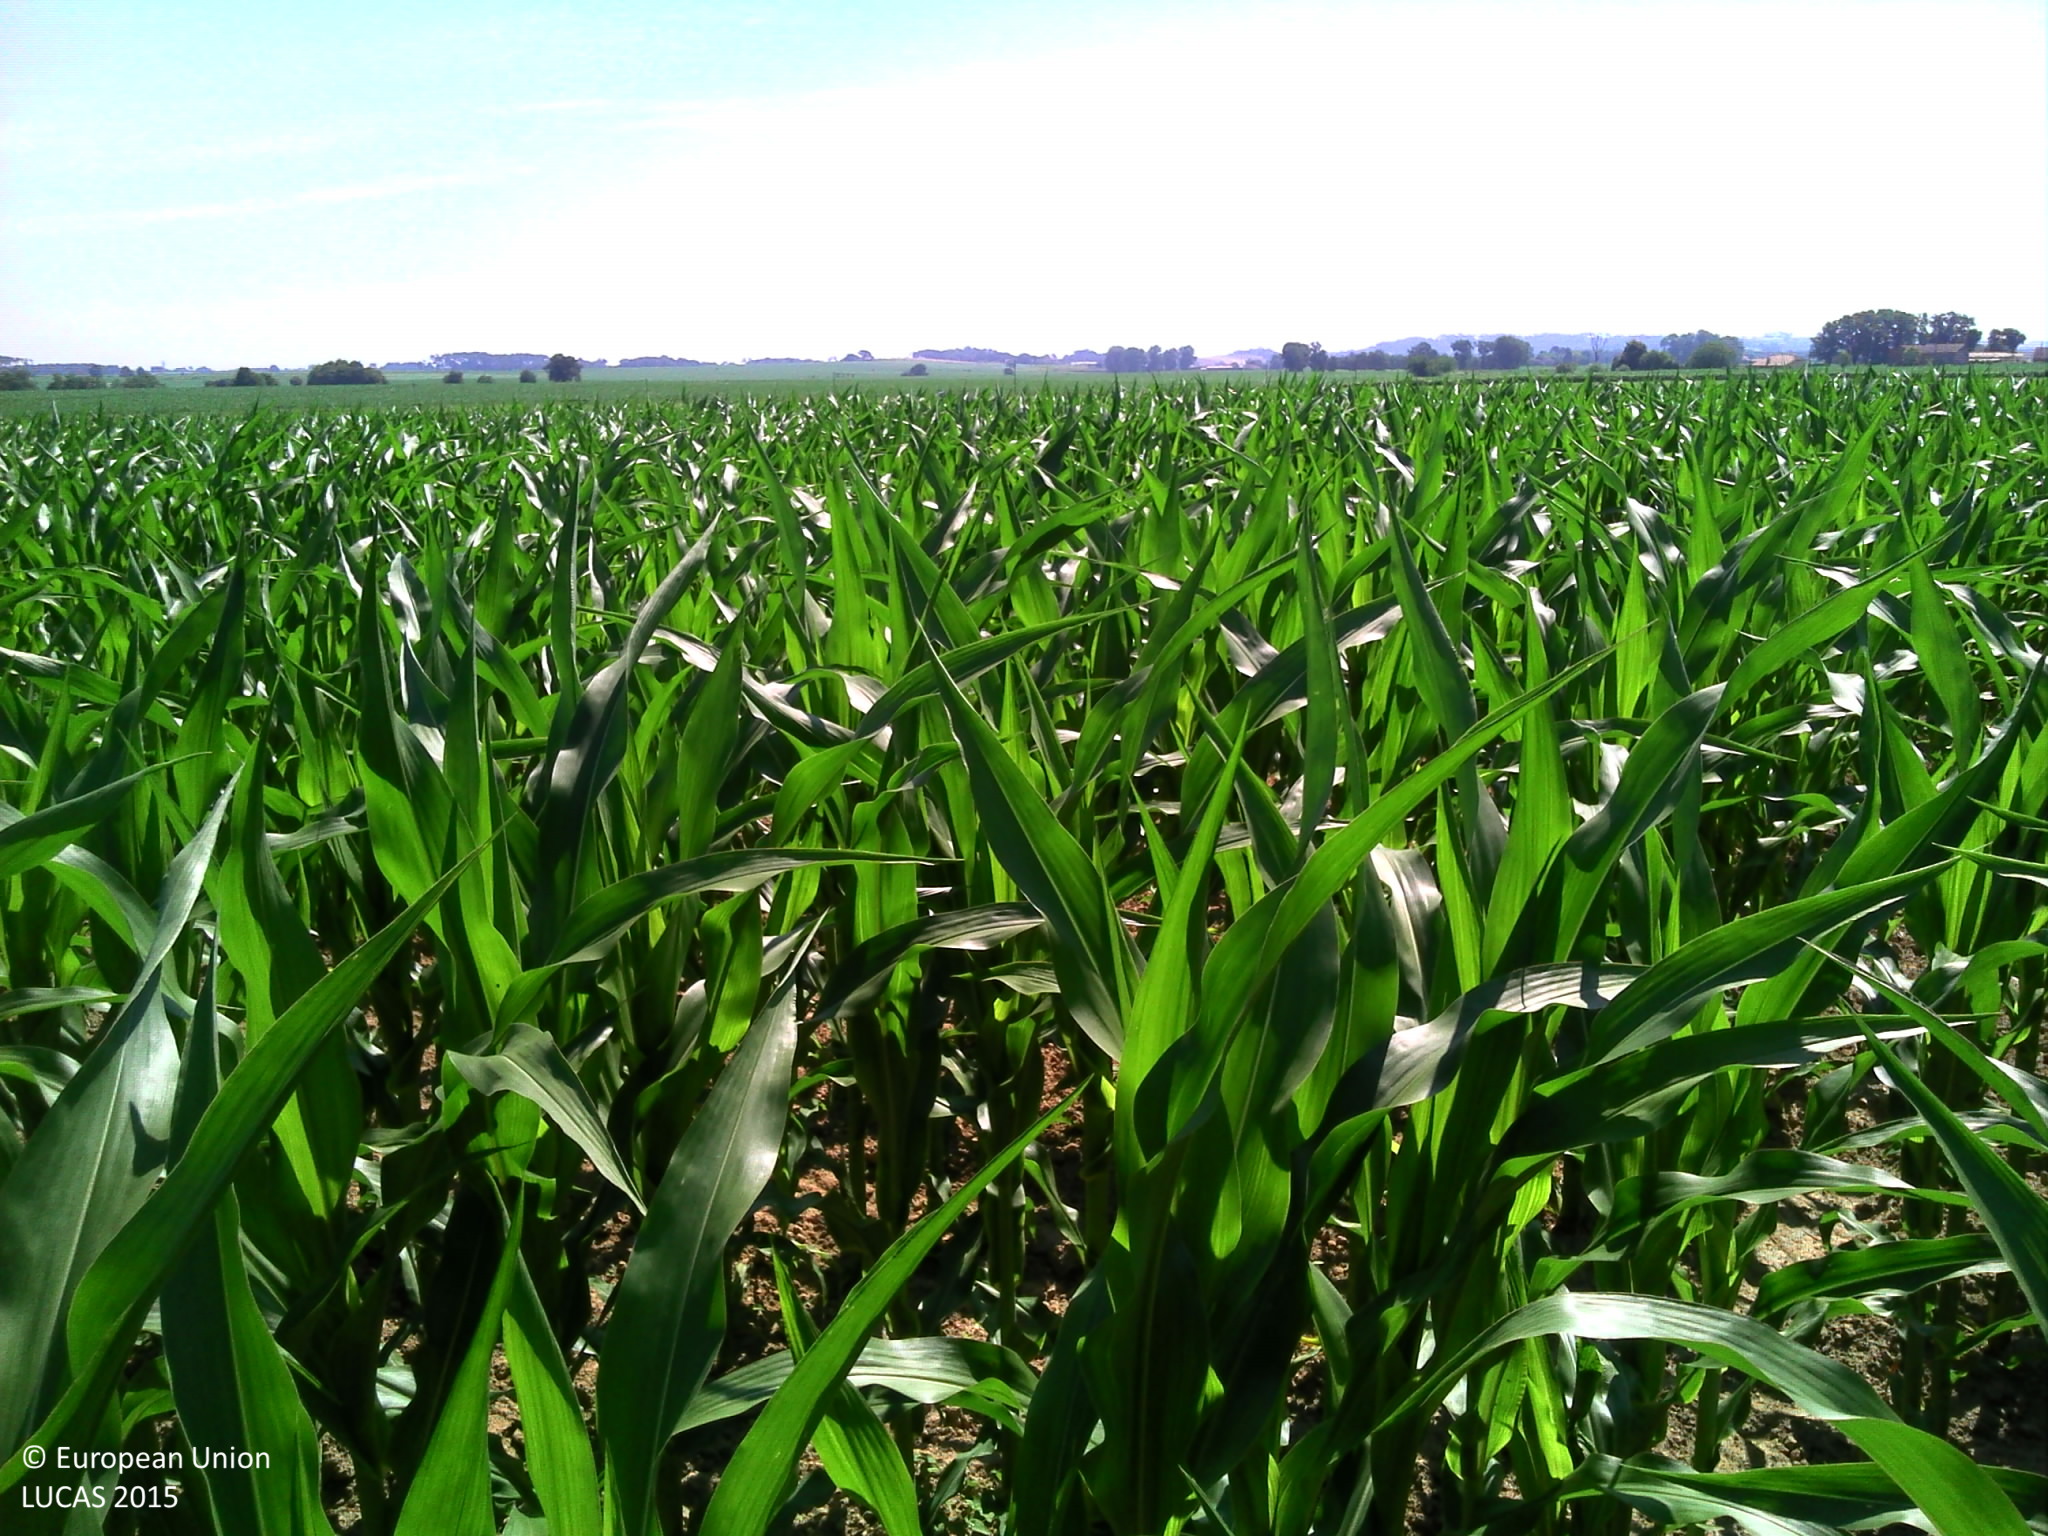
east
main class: Cropland
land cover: Maize
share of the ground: > 75 %
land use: Agriculture (excluding fallow land and kitchen gardens)
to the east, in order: Maize; Grass margins; Ditches and canals; Maize
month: June
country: FR
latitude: 43.6108
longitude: -0.5545
